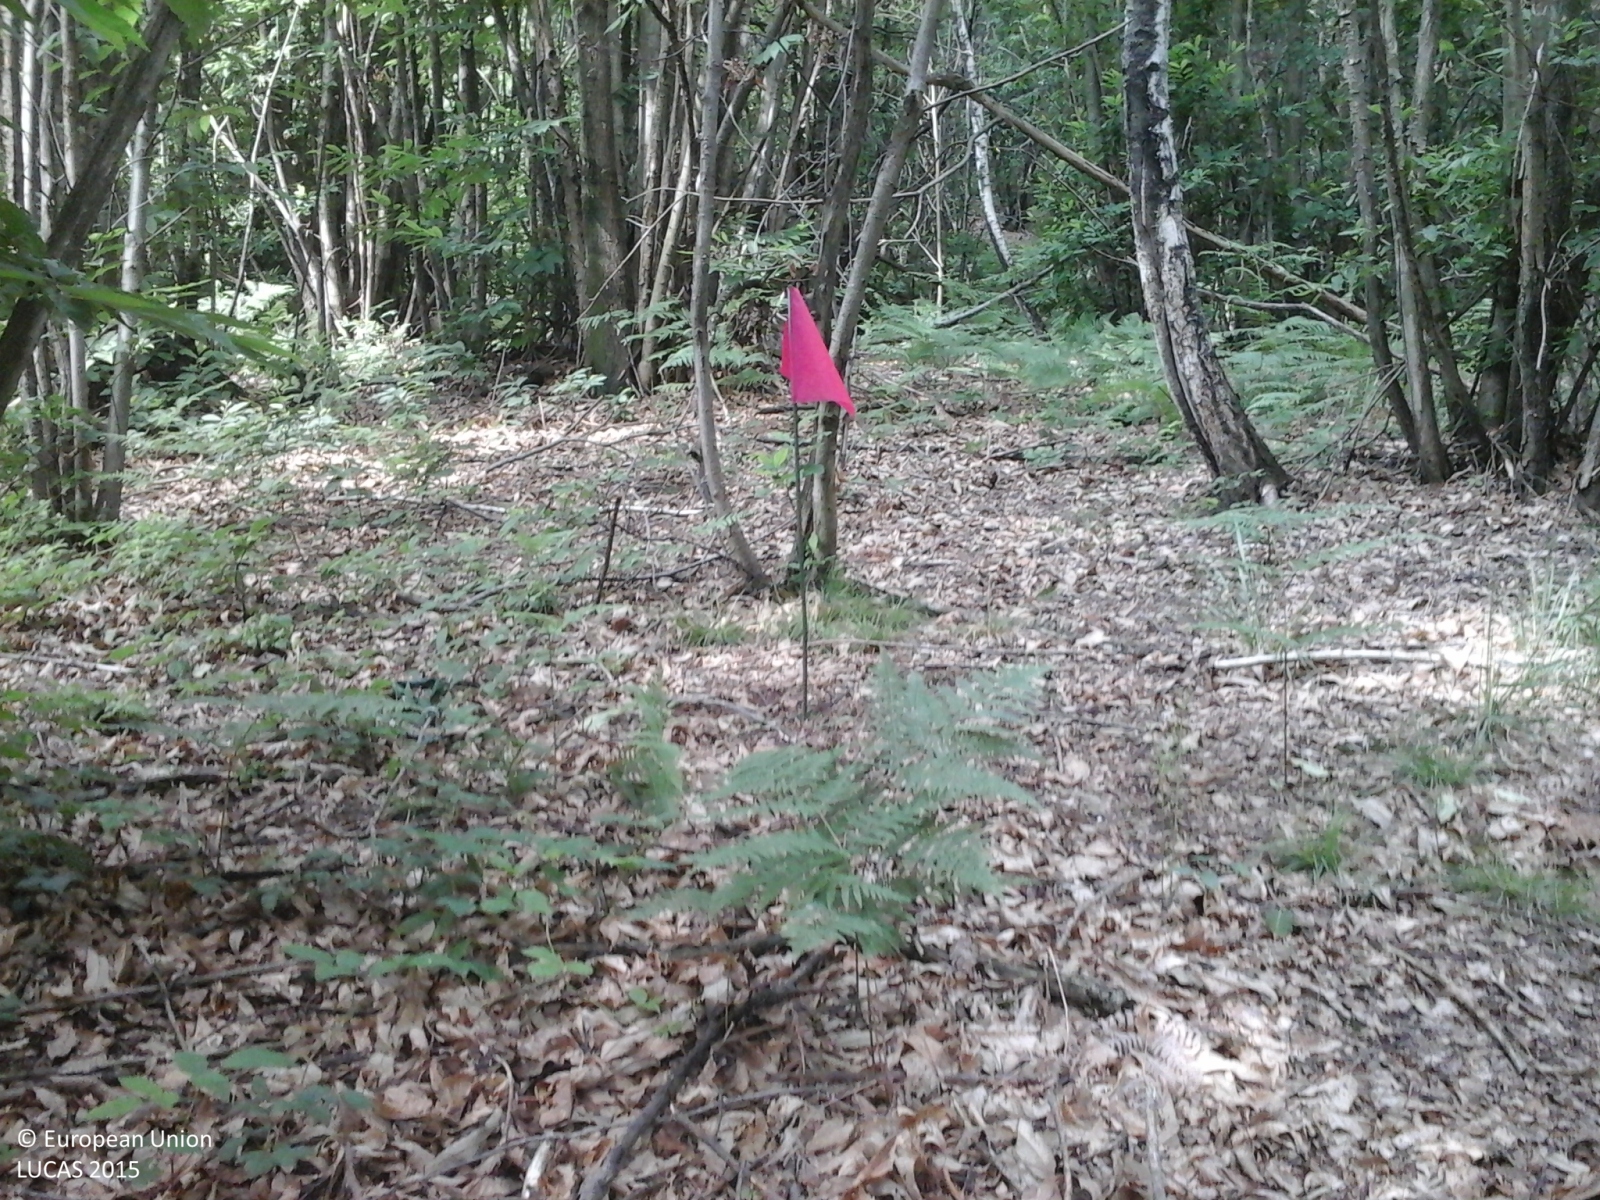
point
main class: Woodland
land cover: Broadleaved woodland
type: thermophilous deciduous forest
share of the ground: > 75 %
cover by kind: broadleaved forest trees 100 %
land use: Forestry
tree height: > 5 m
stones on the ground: < 10 %
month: June
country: IT
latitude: 45.4849
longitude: 7.9690
